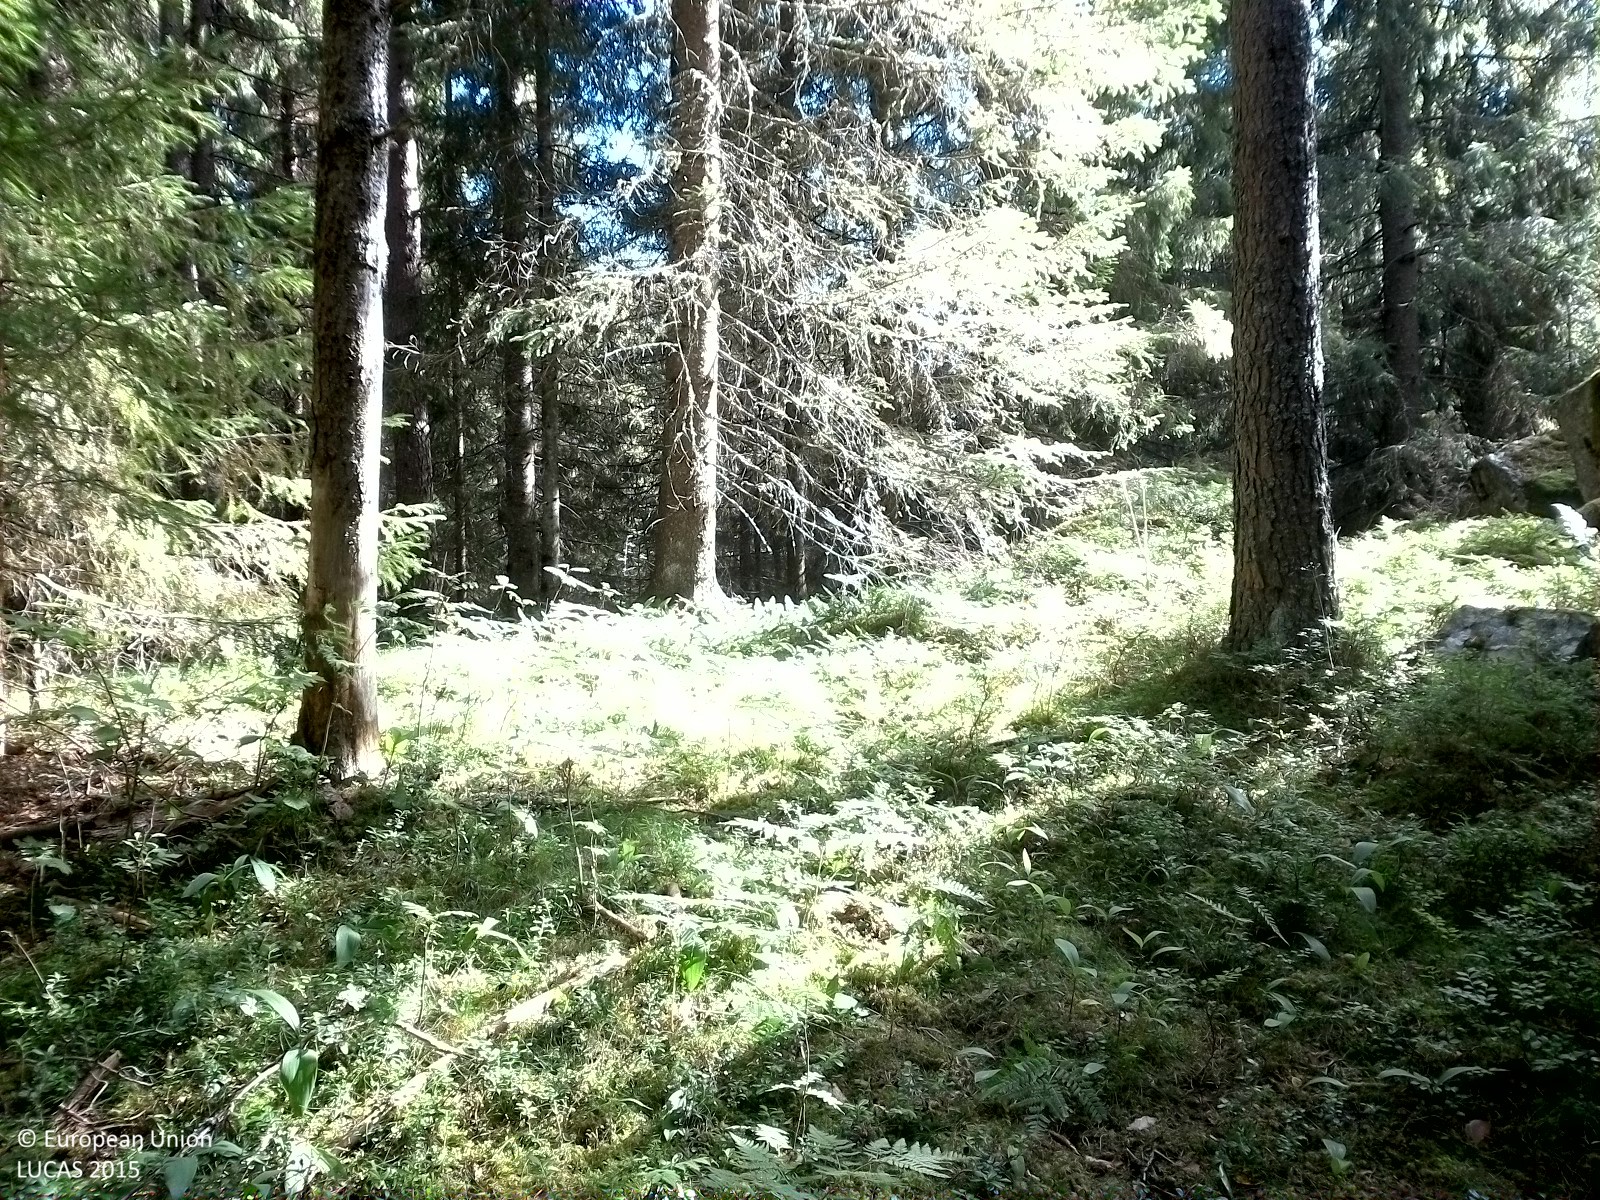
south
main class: Woodland
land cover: Other mixed woodland
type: boreal forest
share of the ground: 50 - 75 %
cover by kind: coniferous forest trees 35 %, lichens and mosses 30 %, broadleaved forest trees 20 %, herbaceous plants 15 %
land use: Forestry
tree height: > 5 m
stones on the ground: < 10 %
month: August
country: SE
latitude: 59.2175
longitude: 14.7391
